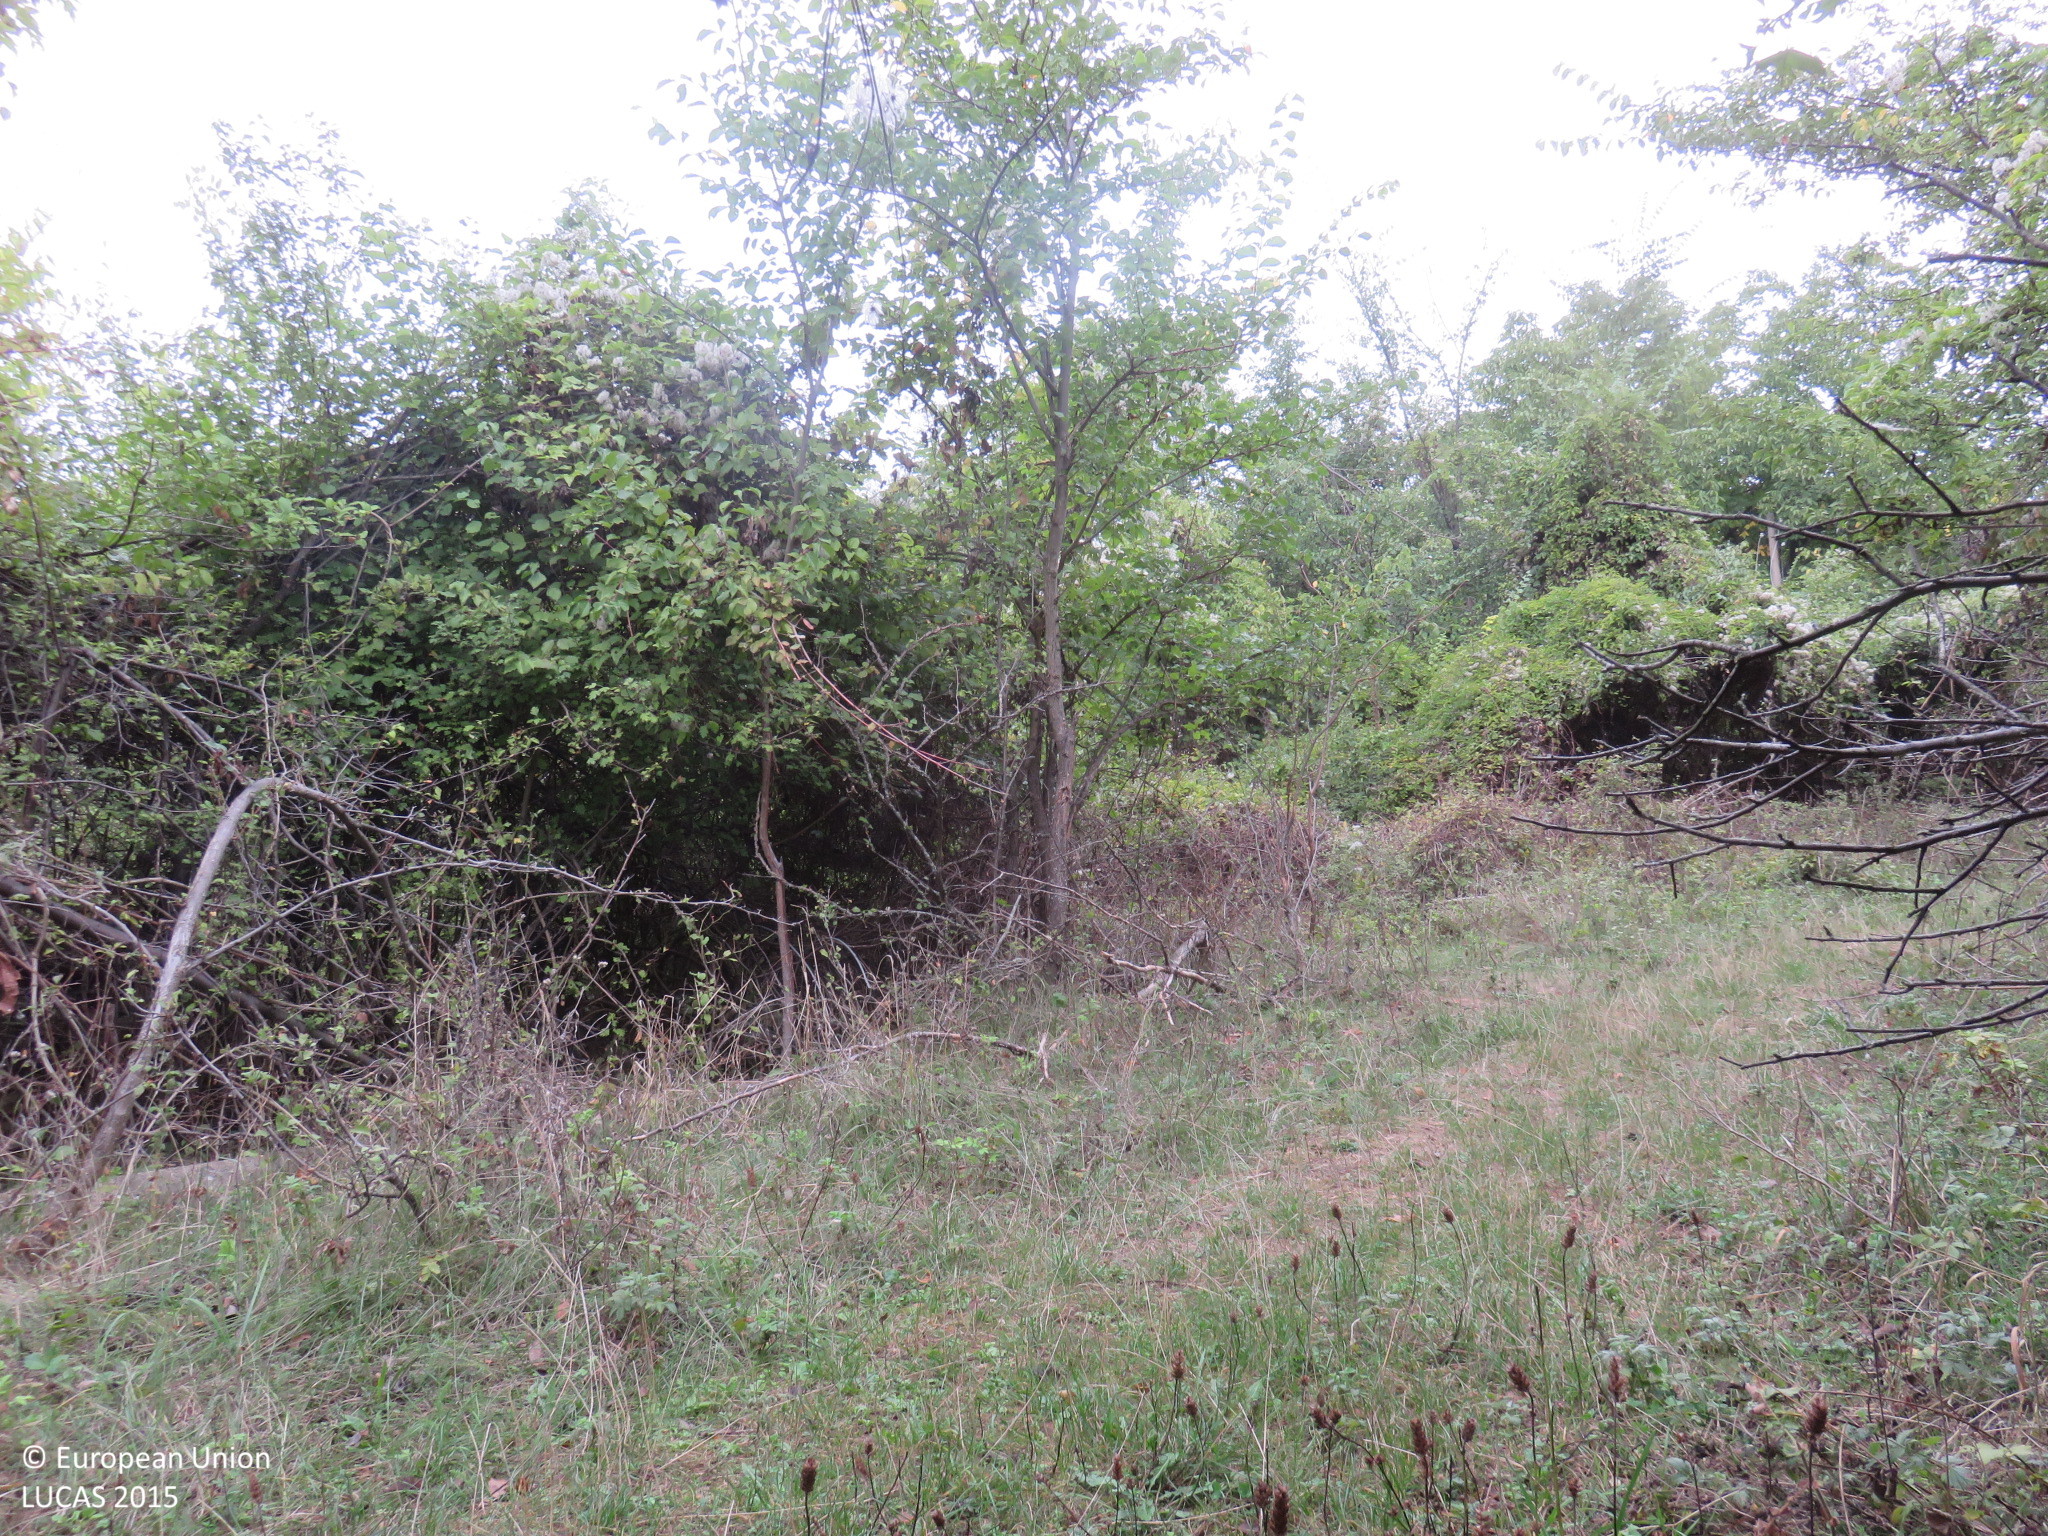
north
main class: Shrubland
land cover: Shrubland with sparse tree cover
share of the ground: > 75 %
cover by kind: shrubs 80 %, herbaceous plants 15 %, broadleaved forest trees 5 %
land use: Semi-natural and natural areas not in use
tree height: < 5 m
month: September
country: BG
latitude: 43.2129
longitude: 24.8989
